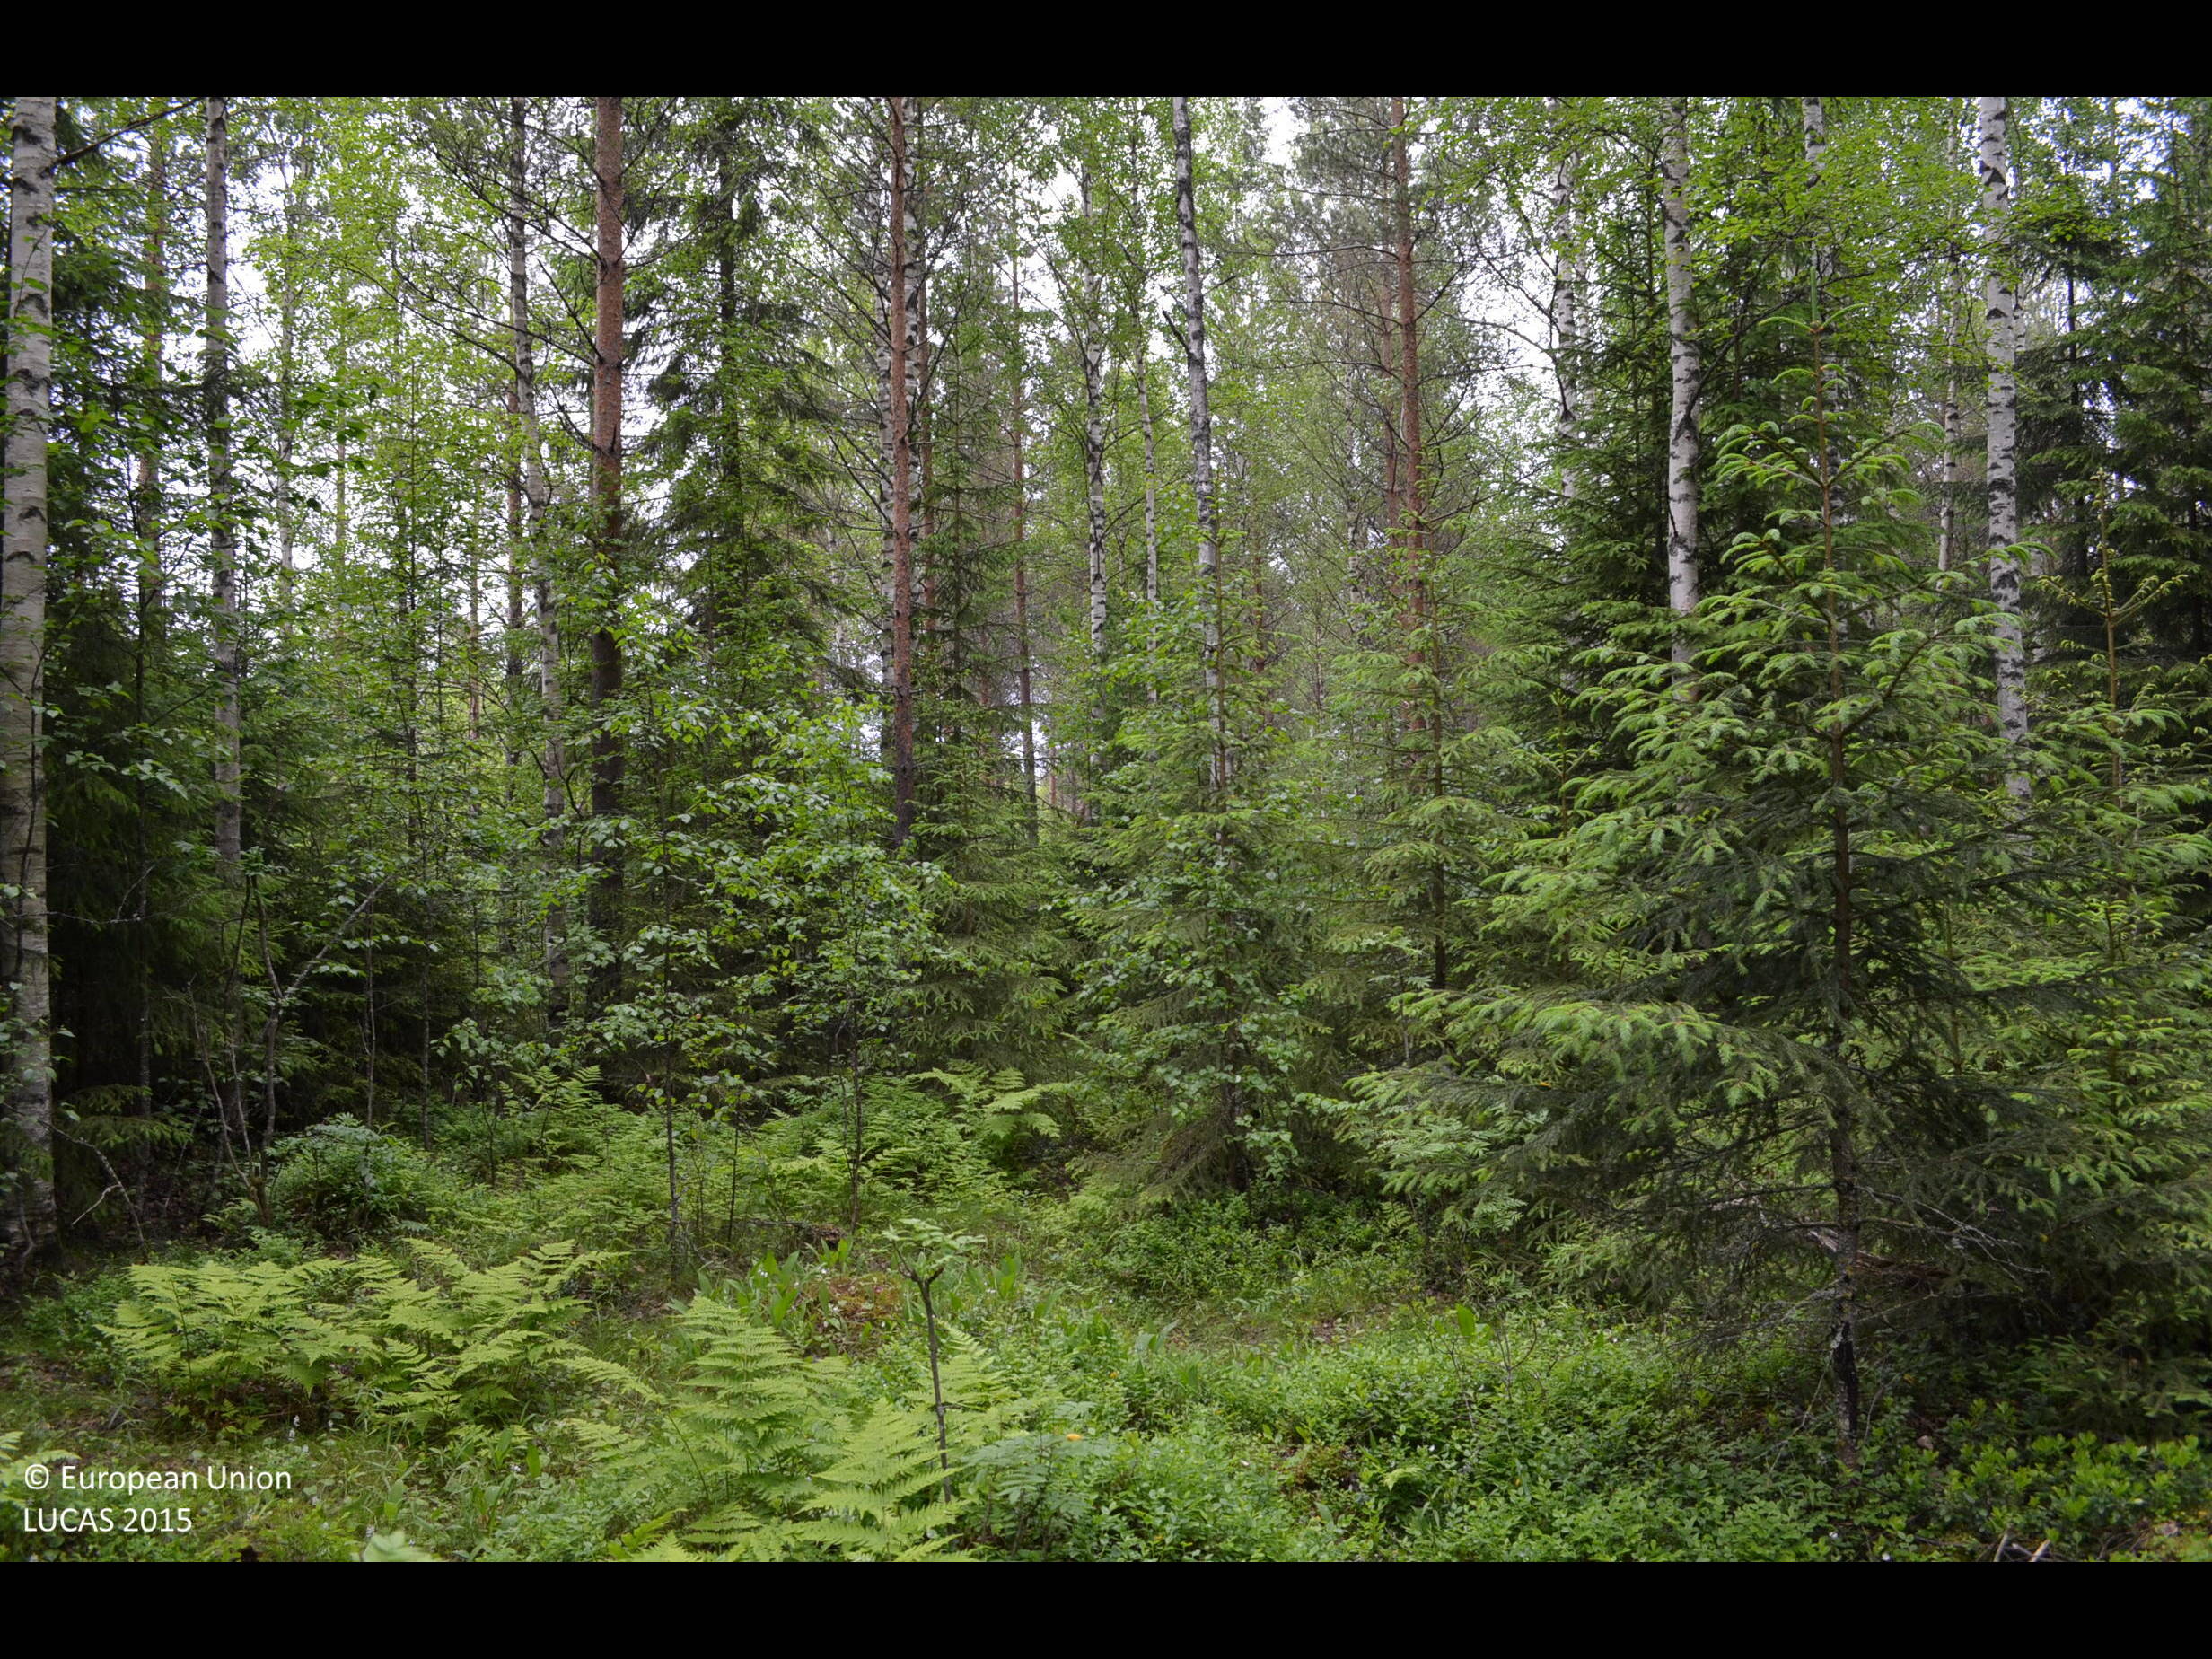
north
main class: Woodland
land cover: Other mixed woodland
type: boreal forest
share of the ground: > 75 %
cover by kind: broadleaved forest trees 45 %, coniferous forest trees 35 %, shrubs 20 %
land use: Forestry
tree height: > 5 m
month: June
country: FI
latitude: 61.7104
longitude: 23.0647
